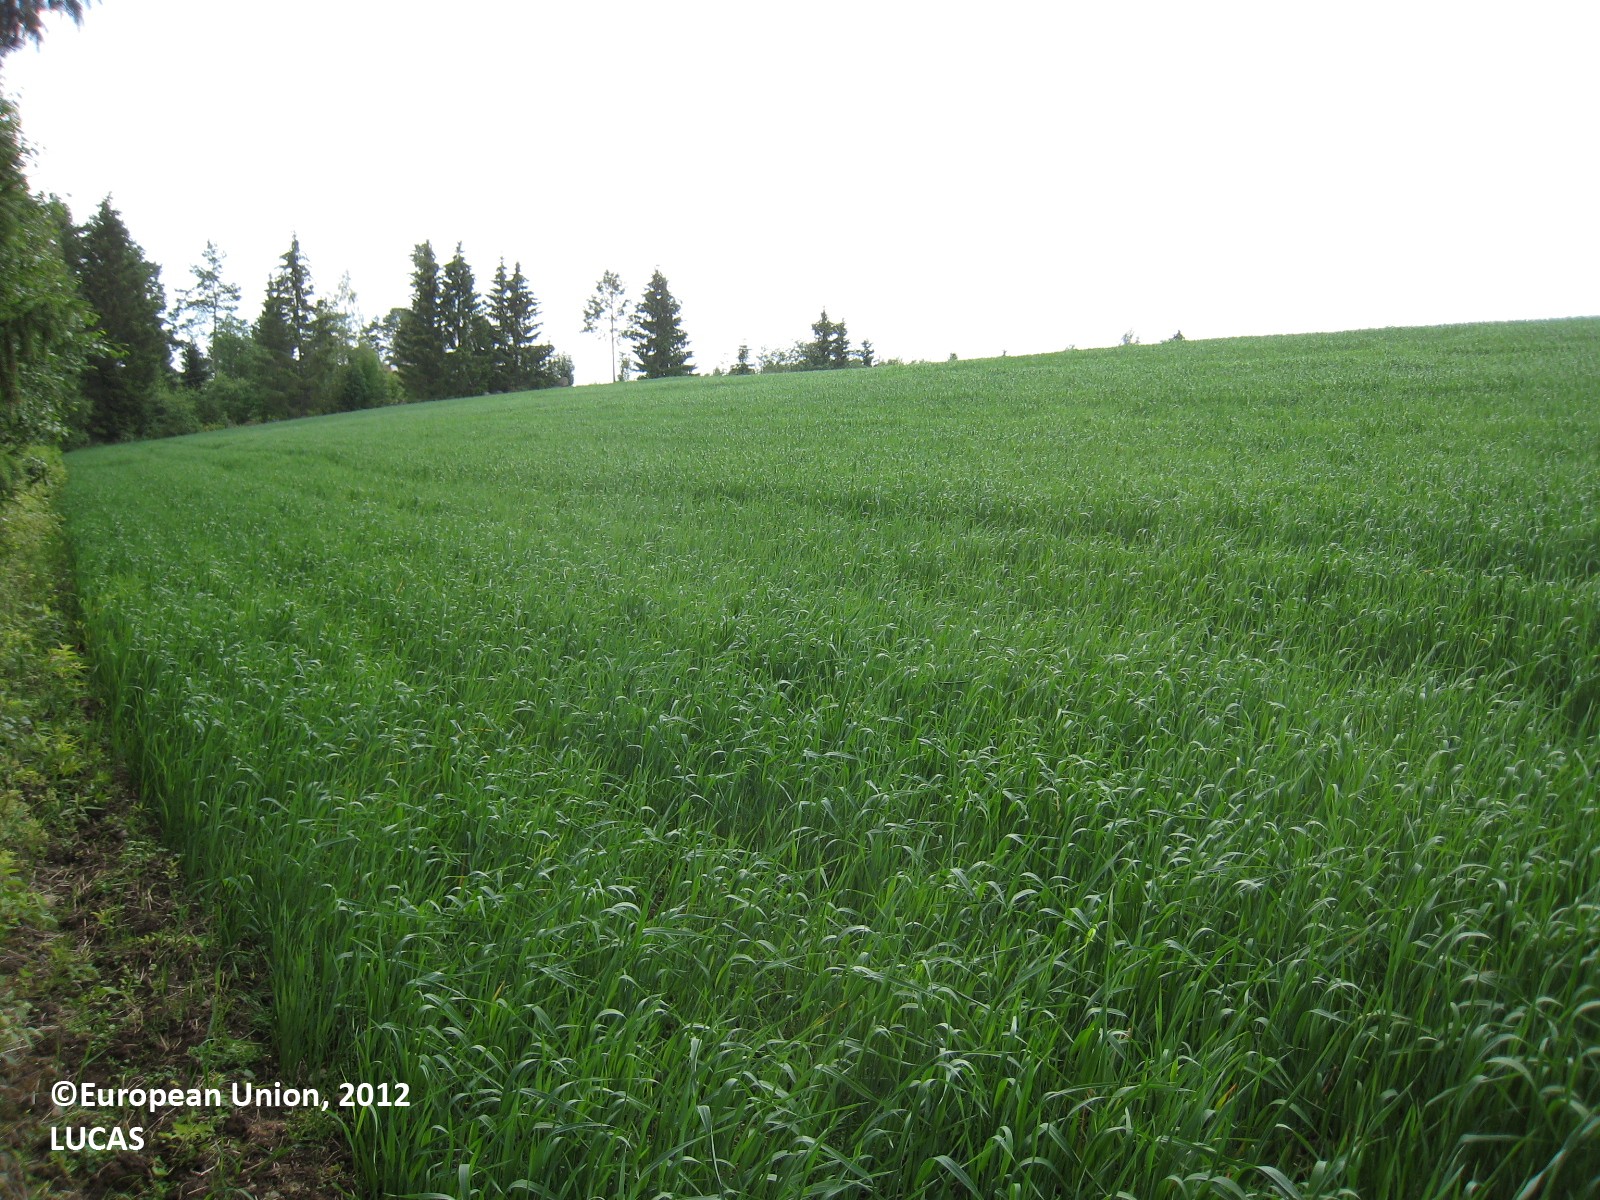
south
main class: Woodland
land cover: Other mixed woodland
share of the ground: > 75 %
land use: Semi-natural and natural areas not in use
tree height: > 5 m
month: July
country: FI
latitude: 61.8677
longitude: 27.0614
